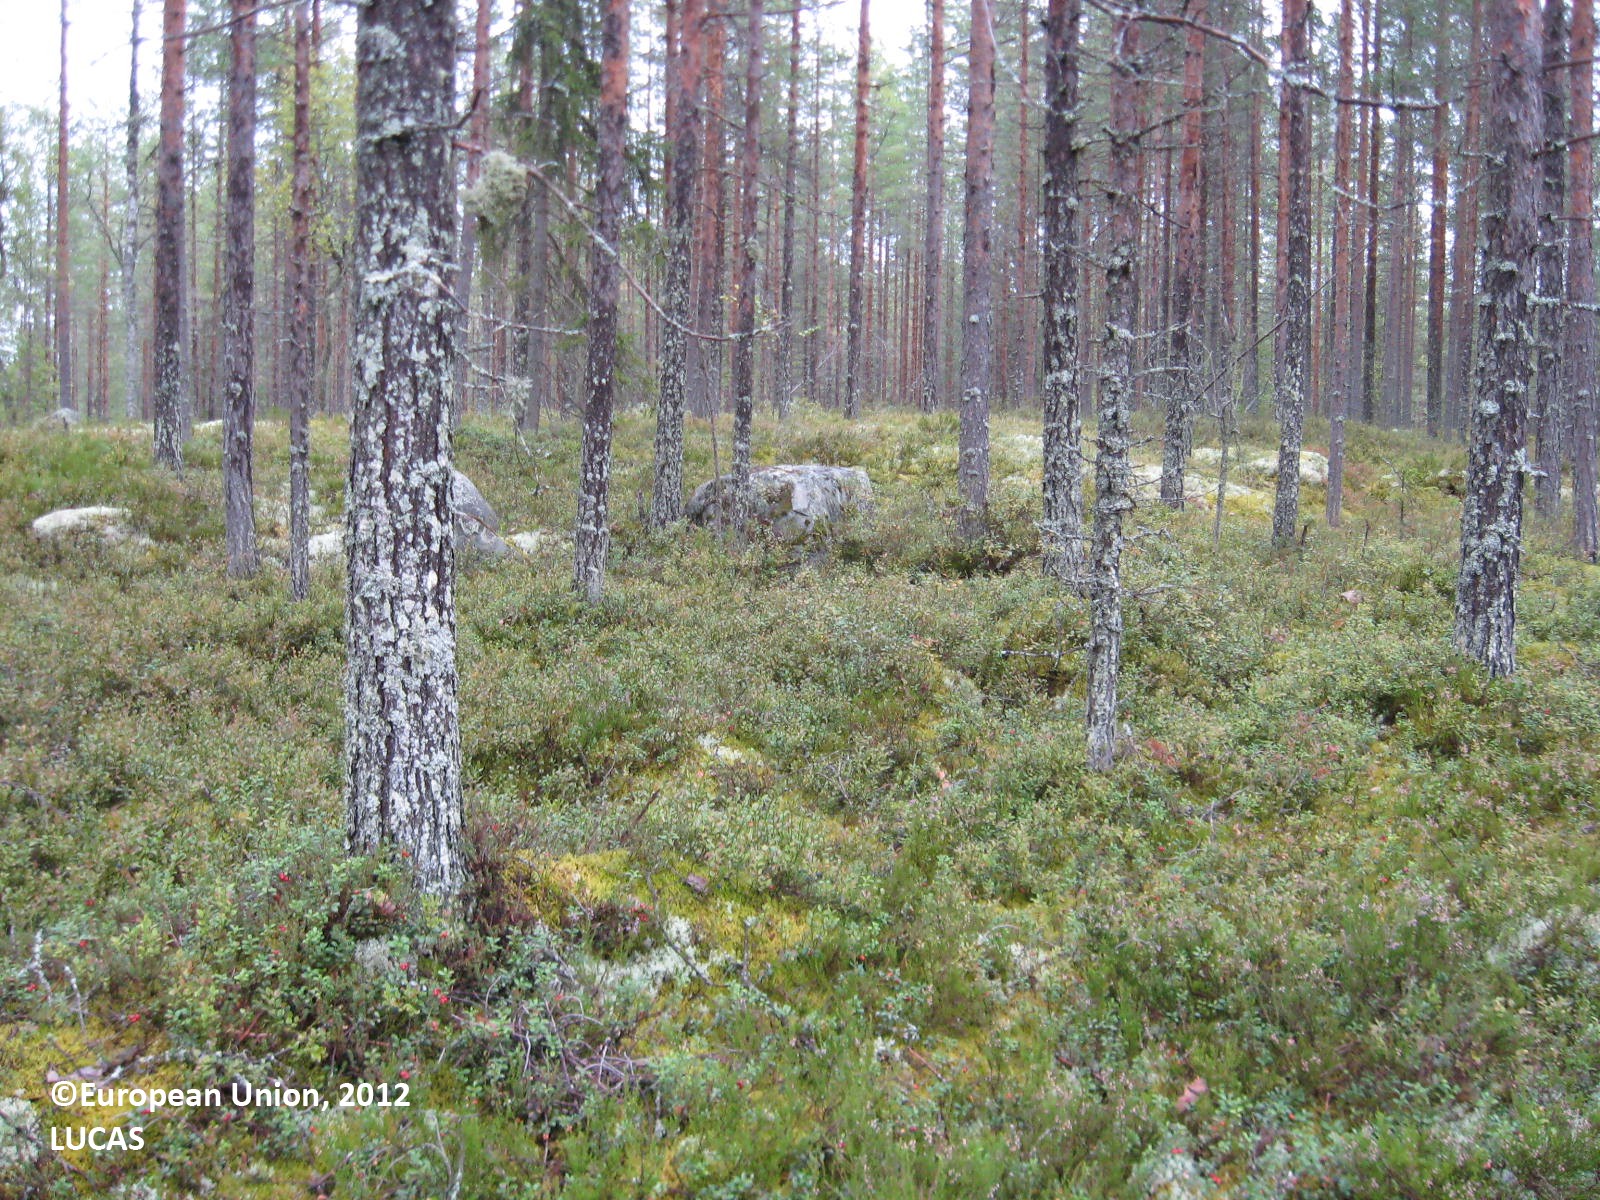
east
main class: Woodland
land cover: Pine dominated coniferous woodland
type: boreal forest
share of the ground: > 75 %
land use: Forestry
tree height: > 5 m
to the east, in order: Pine dominated coniferous woodland; Spruce dominated coniferous woodland; Pine dominated coniferous woodland
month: August
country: FI
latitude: 63.4859
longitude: 29.3559
